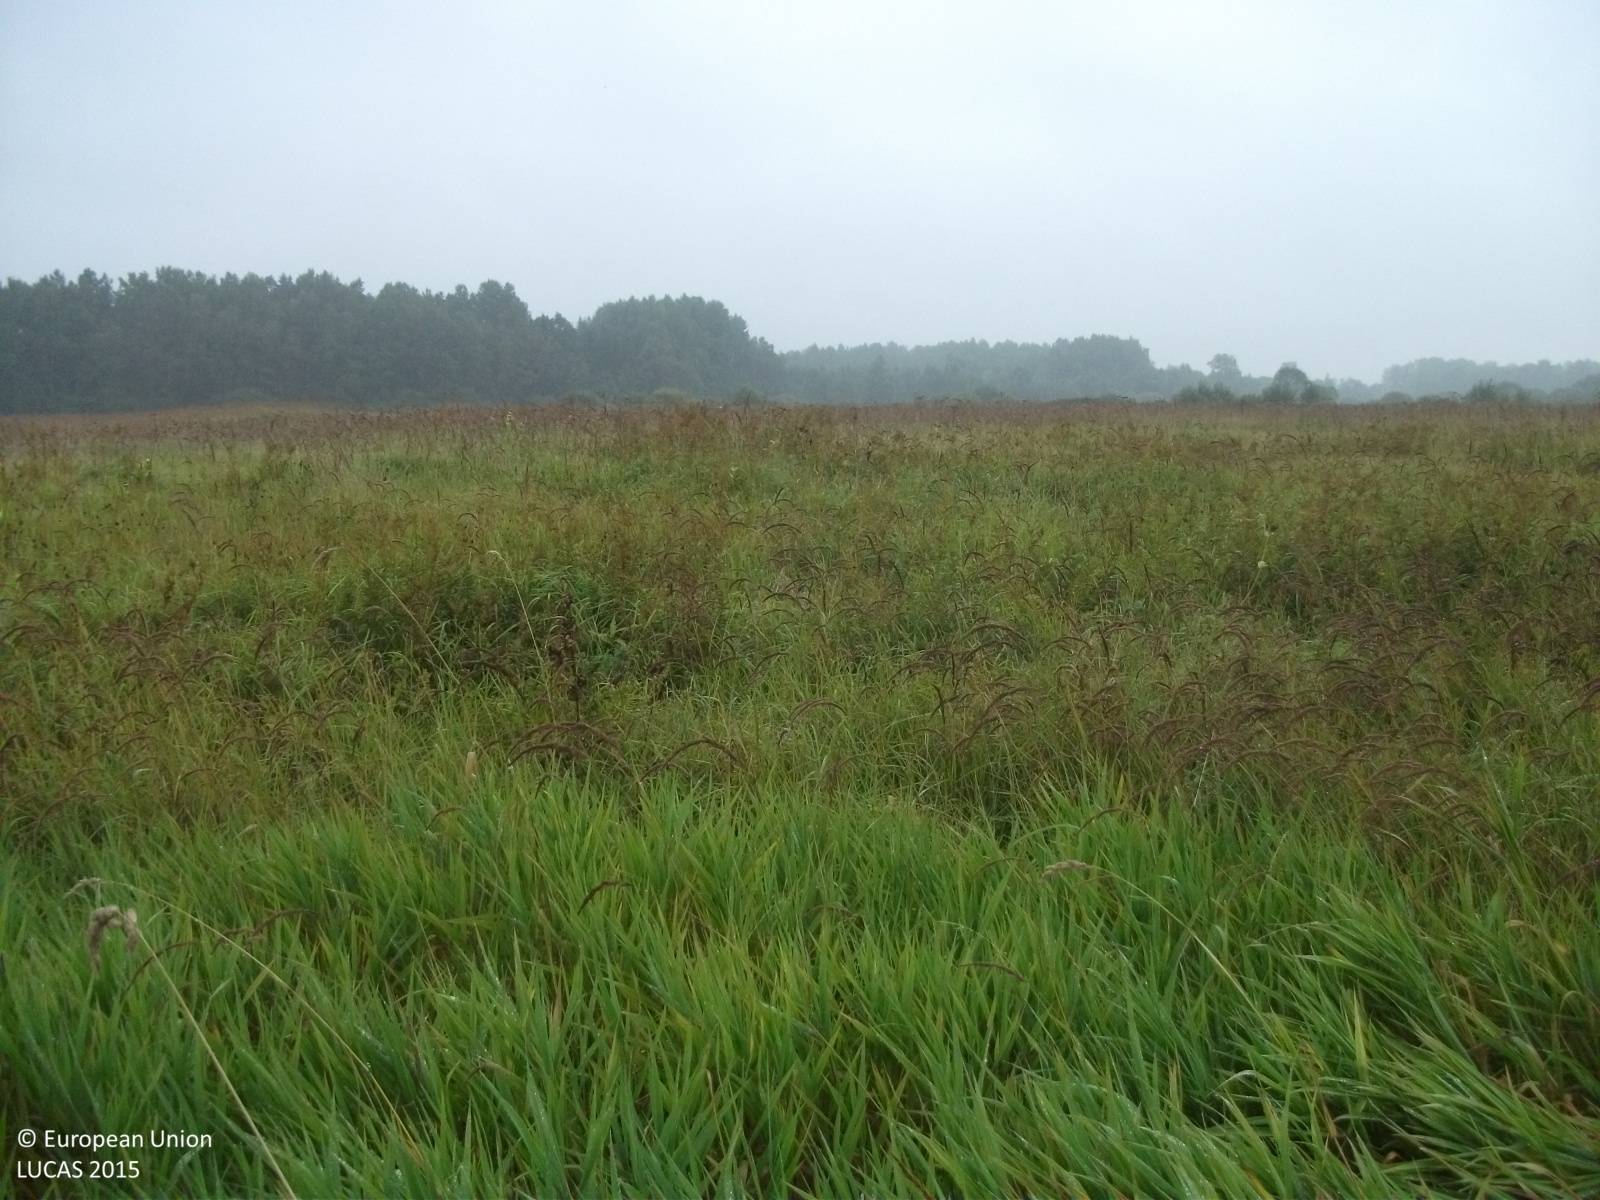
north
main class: Grassland
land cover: Grassland without tree/shrub cover
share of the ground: > 75 %
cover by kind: herbaceous plants 100 %
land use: Agriculture (excluding fallow land and kitchen gardens)
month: September
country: LV
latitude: 57.5042
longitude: 24.6302
